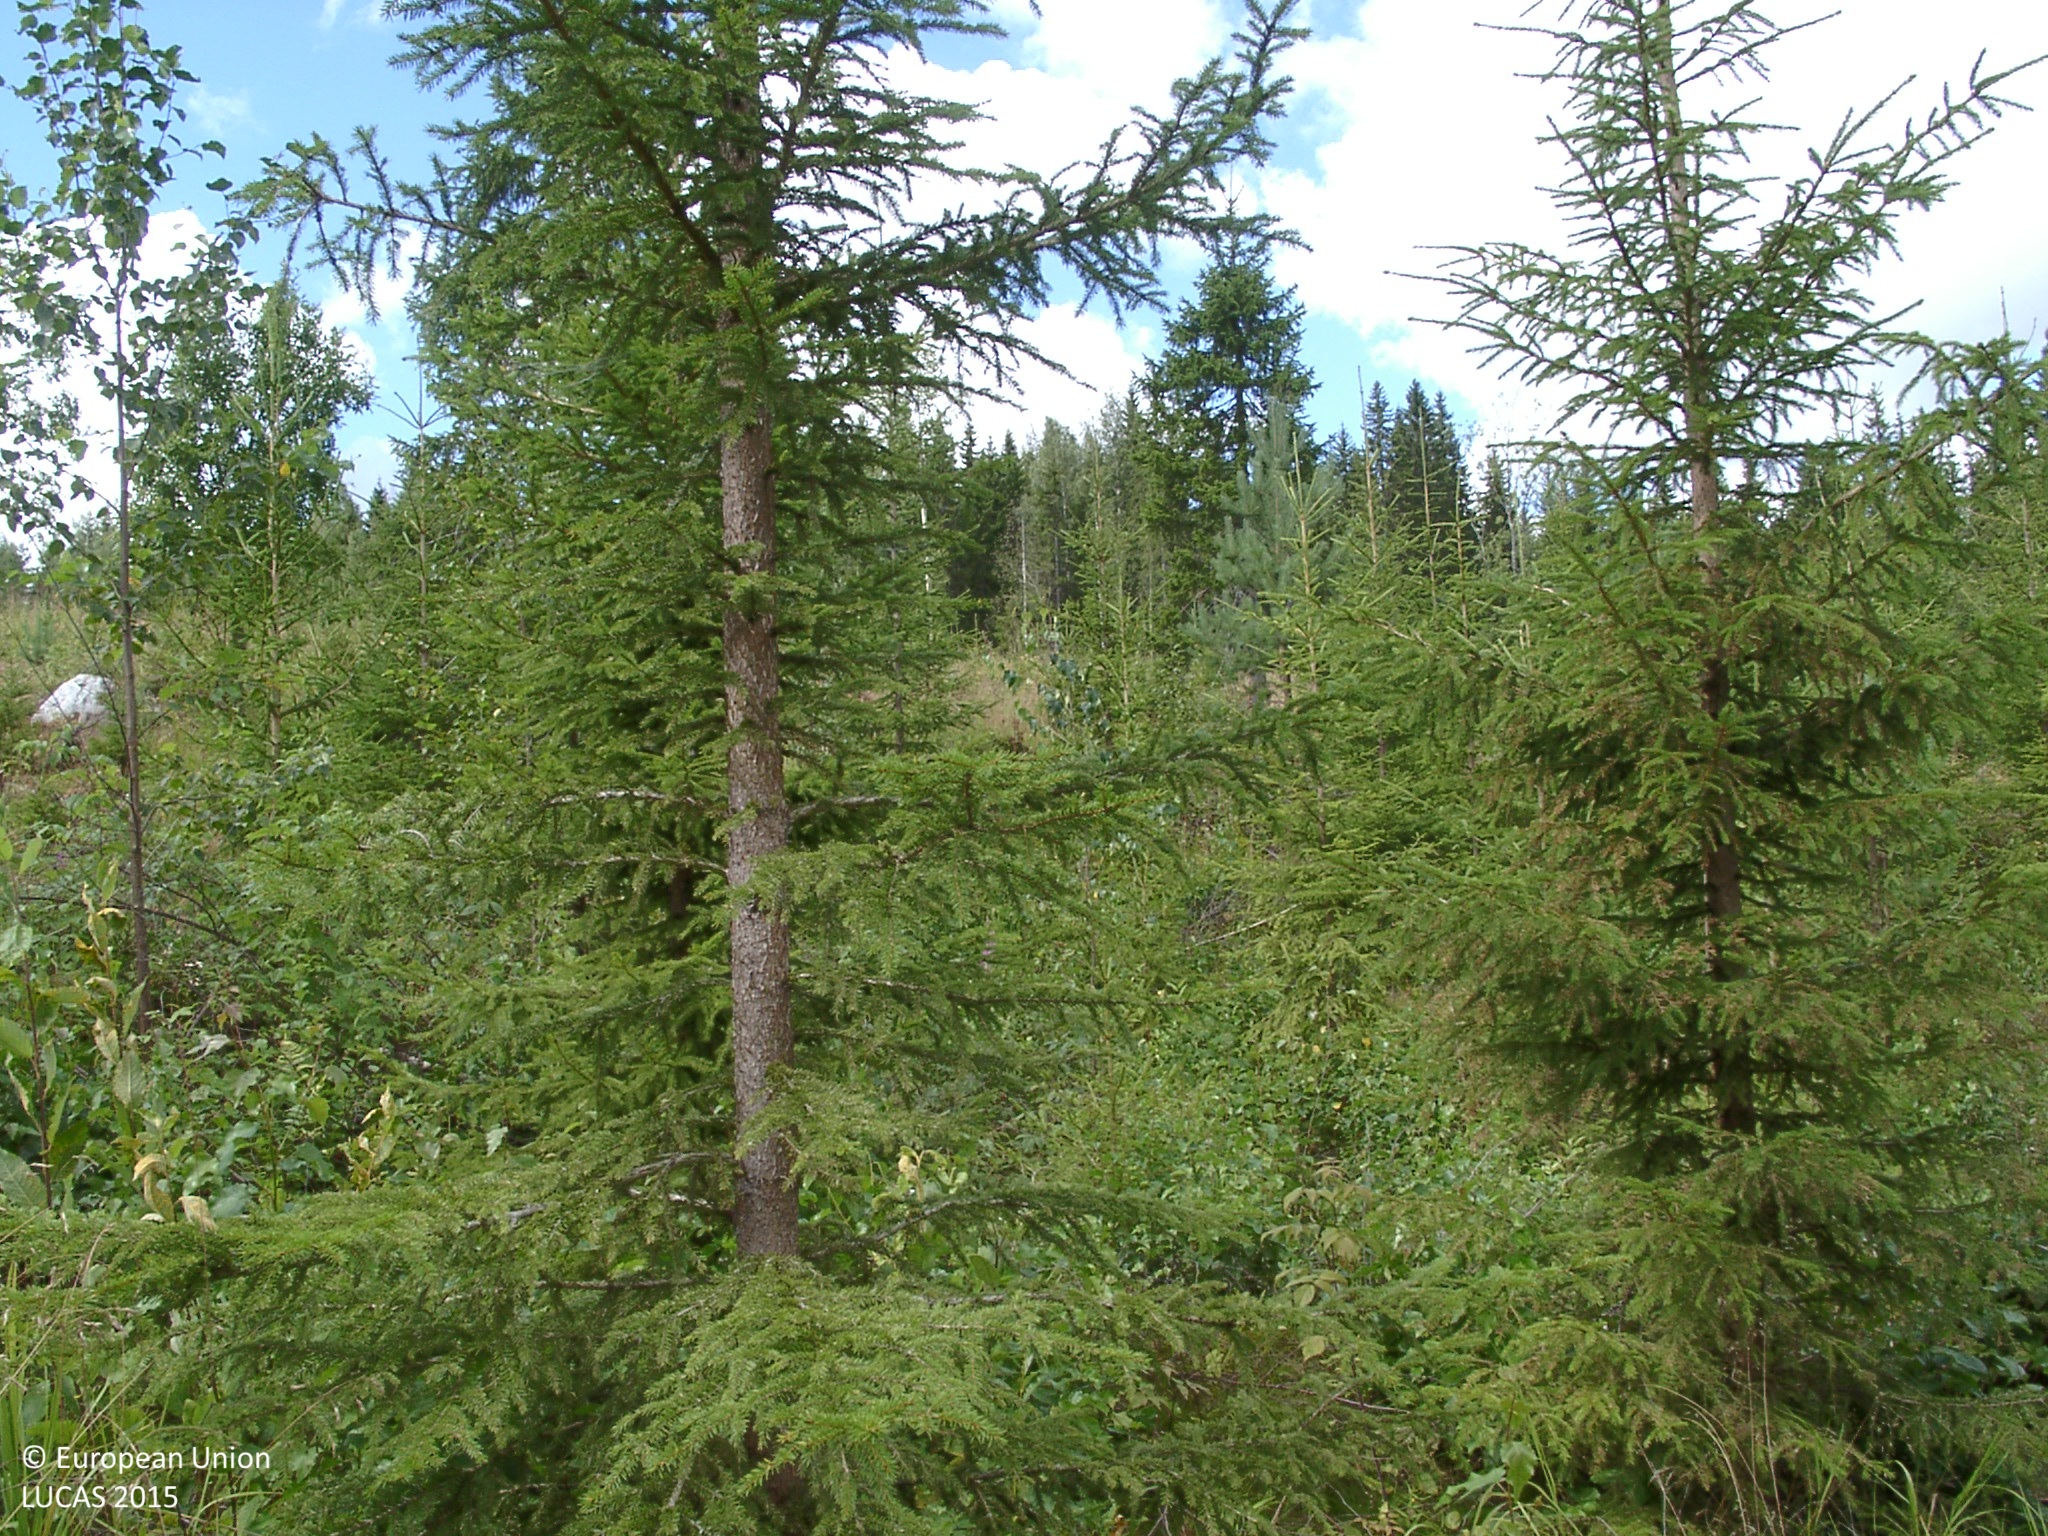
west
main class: Woodland
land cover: Other coniferous woodland
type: boreal forest
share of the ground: 50 - 75 %
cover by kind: coniferous forest trees 50 %, broadleaved forest trees 15 %, shrubs 10 %, herbaceous plants 10 %, lichens and mosses 5 %
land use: Forestry
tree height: < 5 m
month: August
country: FI
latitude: 62.3467
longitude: 25.5855
